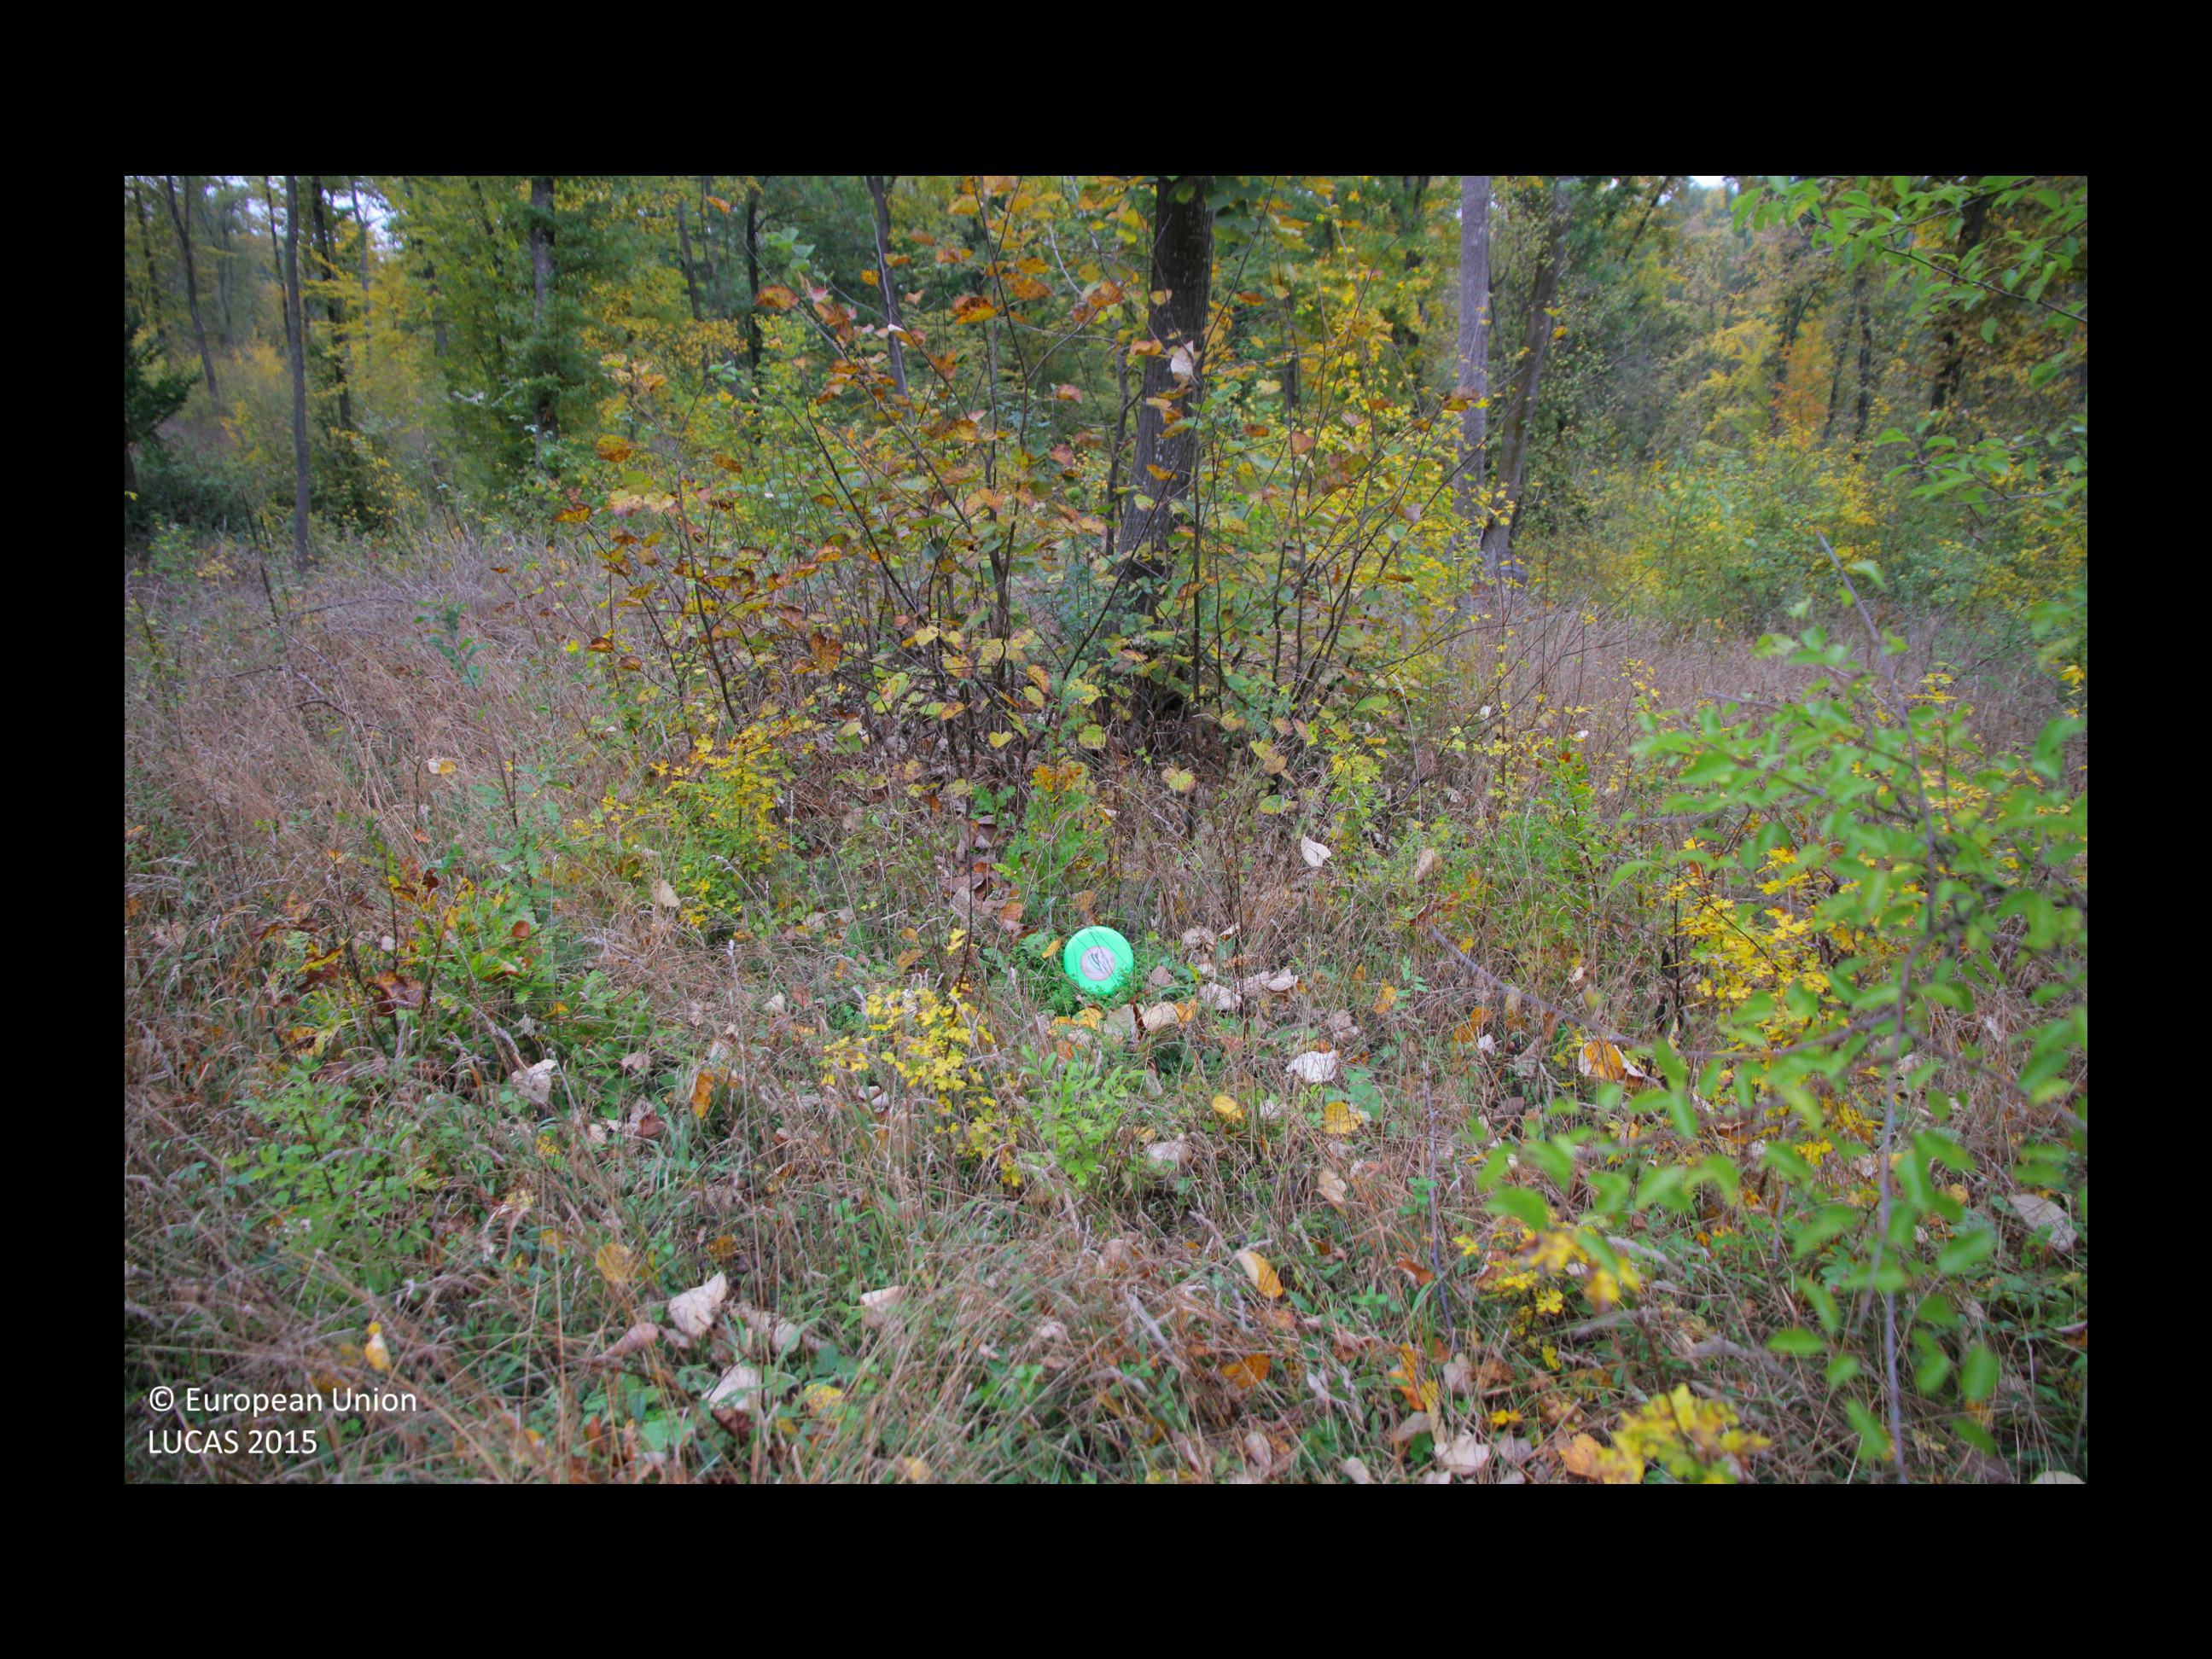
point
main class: Woodland
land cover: Broadleaved woodland
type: mesophytic deciduous forest
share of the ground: 50 - 75 %
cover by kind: broadleaved forest trees 70 %, herbaceous plants 20 %, shrubs 10 %
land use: Forestry
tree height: > 5 m
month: October
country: BG
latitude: 43.7980
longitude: 26.6802
